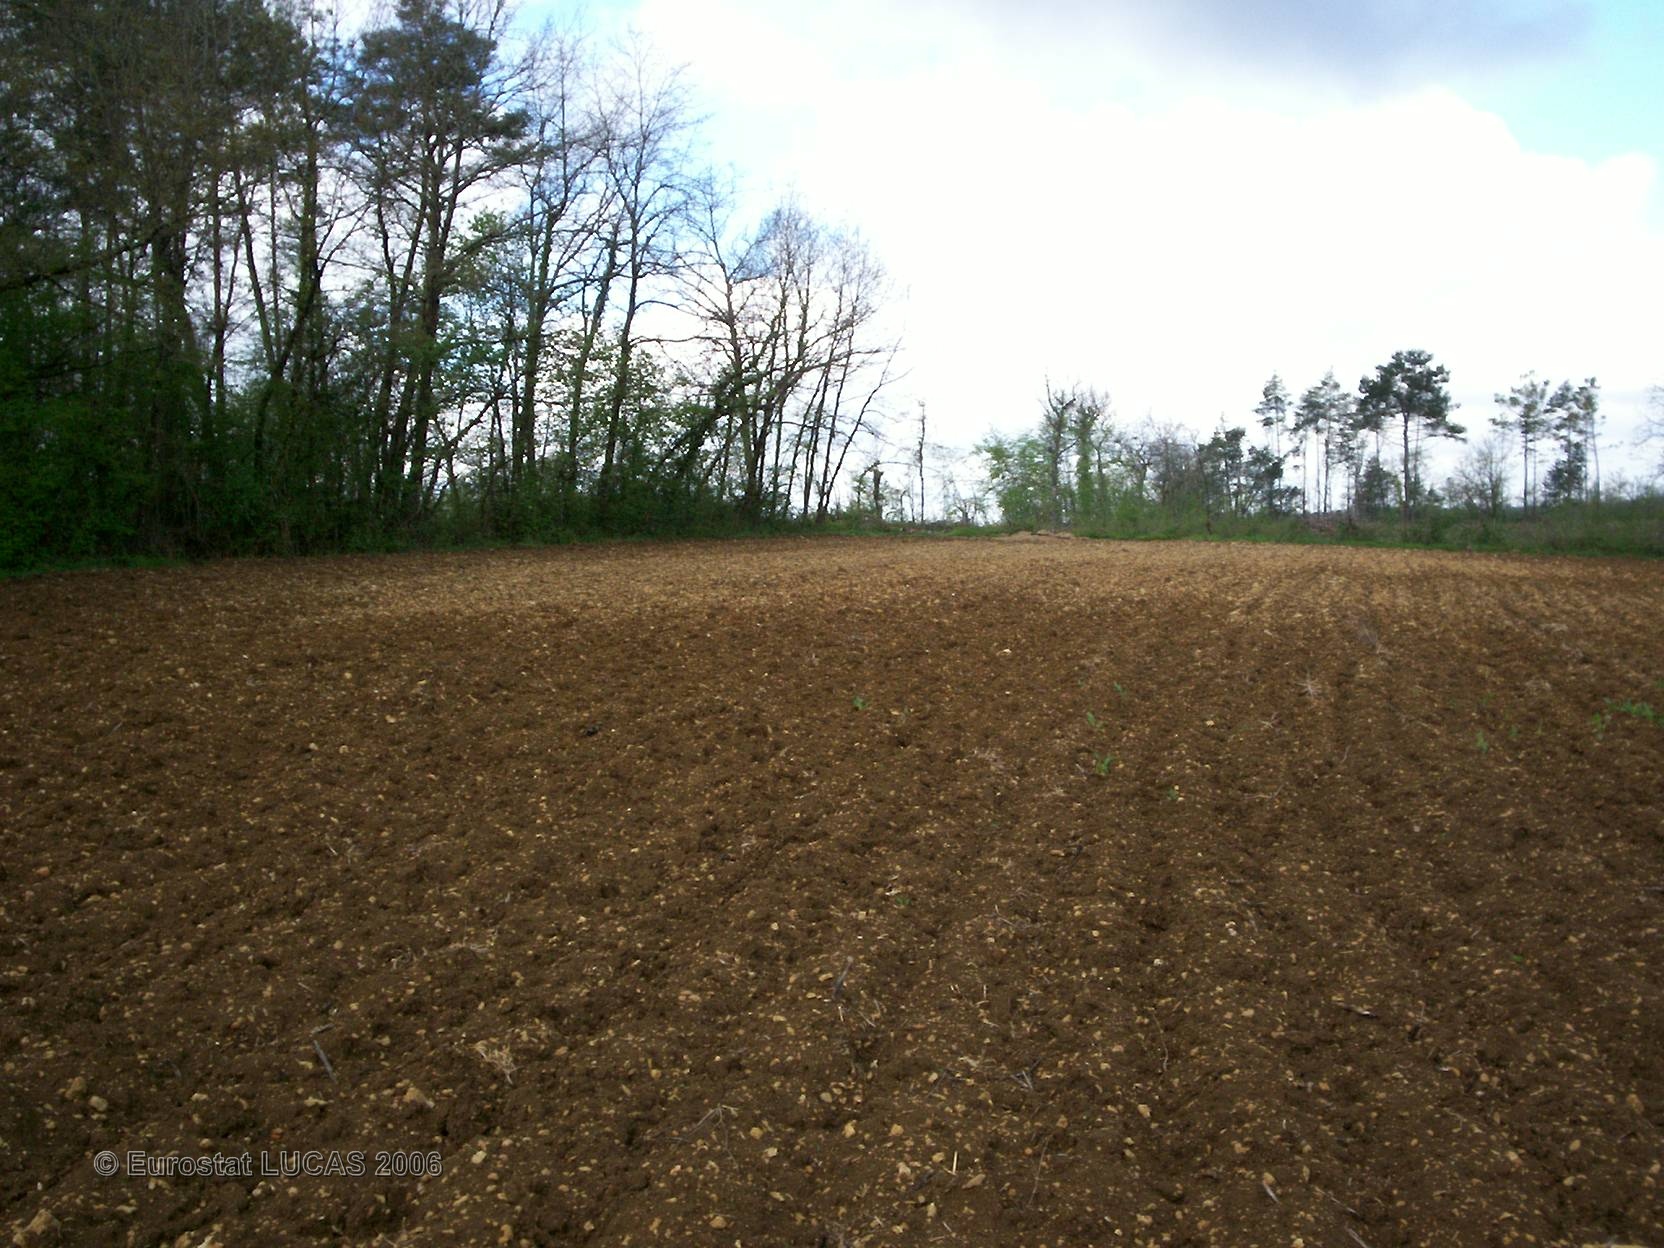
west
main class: Cropland
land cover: Maize
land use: Agriculture (excluding fallow land and kitchen gardens)
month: June
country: FR
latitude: 45.3881
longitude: 0.7550
